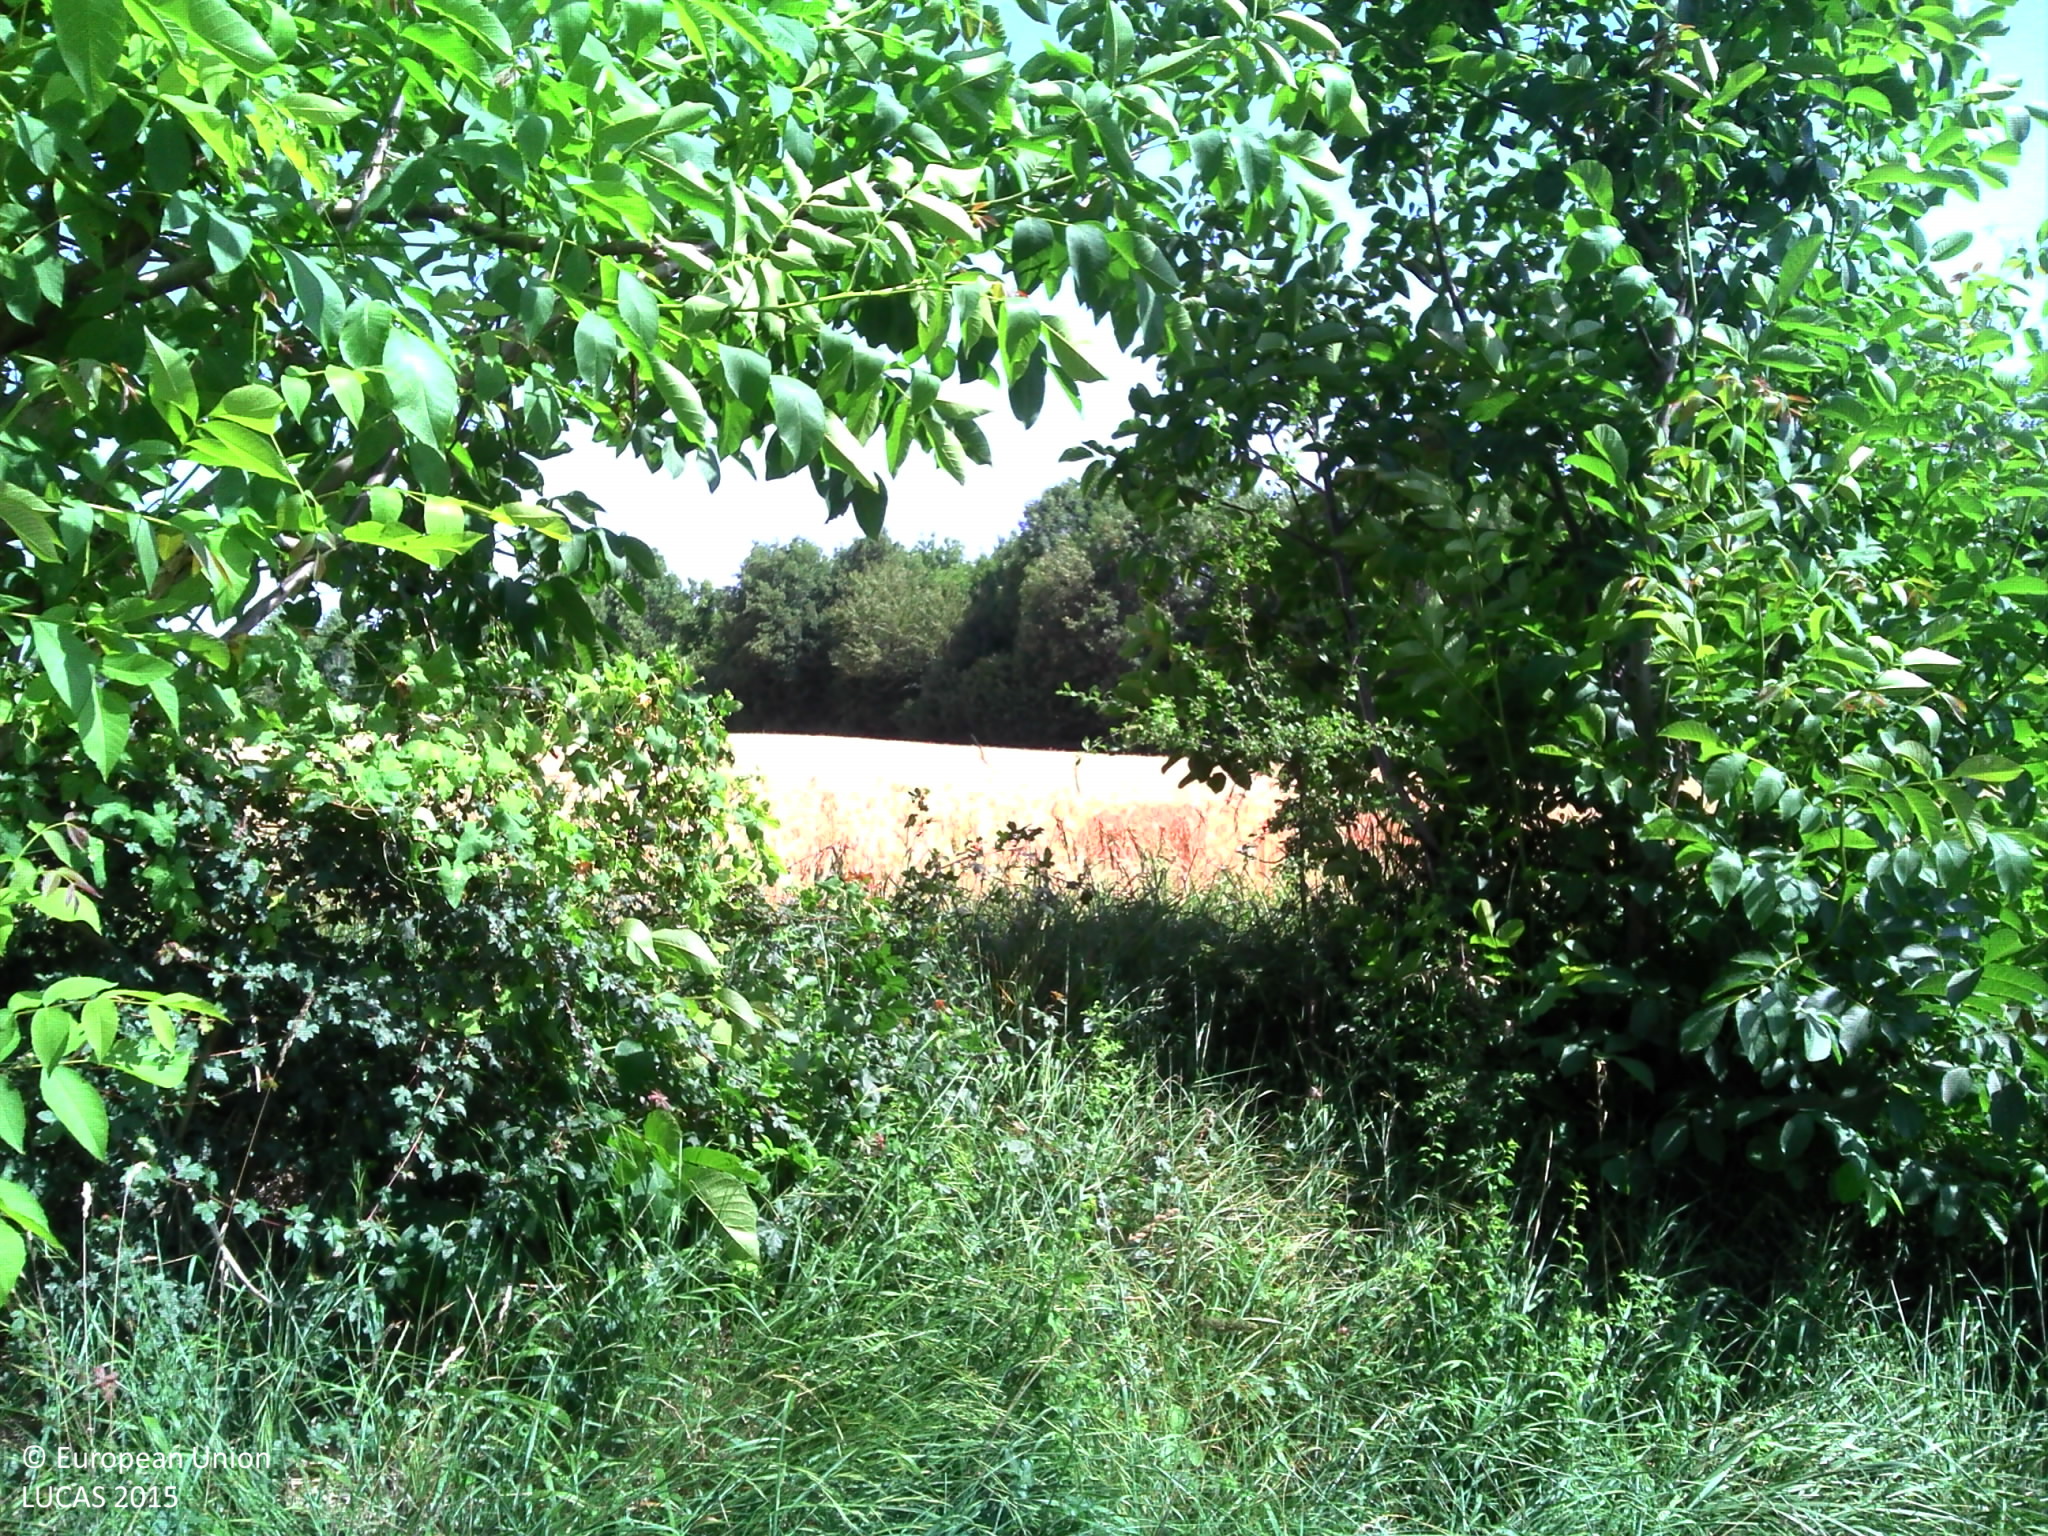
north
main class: Cropland
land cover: Durum wheat
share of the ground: > 75 %
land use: Agriculture (excluding fallow land and kitchen gardens)
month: July
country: FR
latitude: 45.7837
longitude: 5.4121
